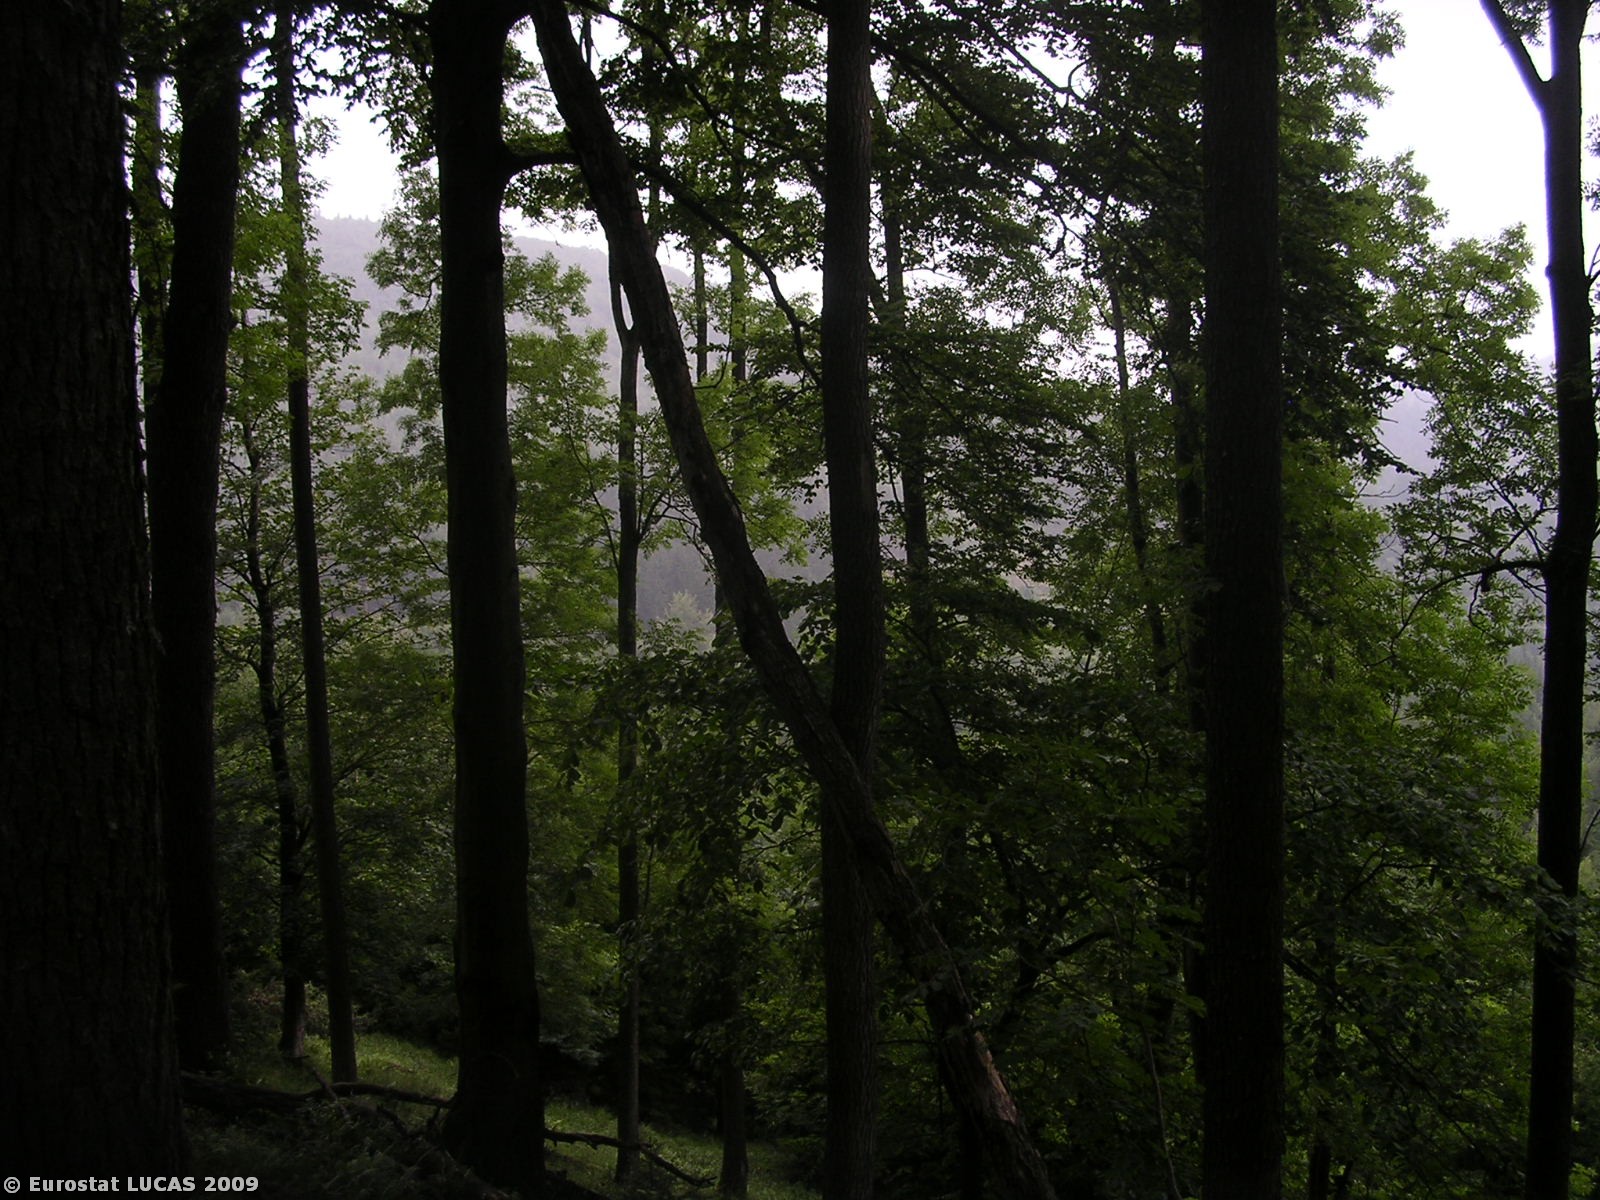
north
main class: Woodland
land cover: Broadleaved woodland
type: mountainous beech forest
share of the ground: > 75 %
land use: Forestry
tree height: > 5 m
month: July
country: CZ
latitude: 50.7956
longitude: 14.5561
